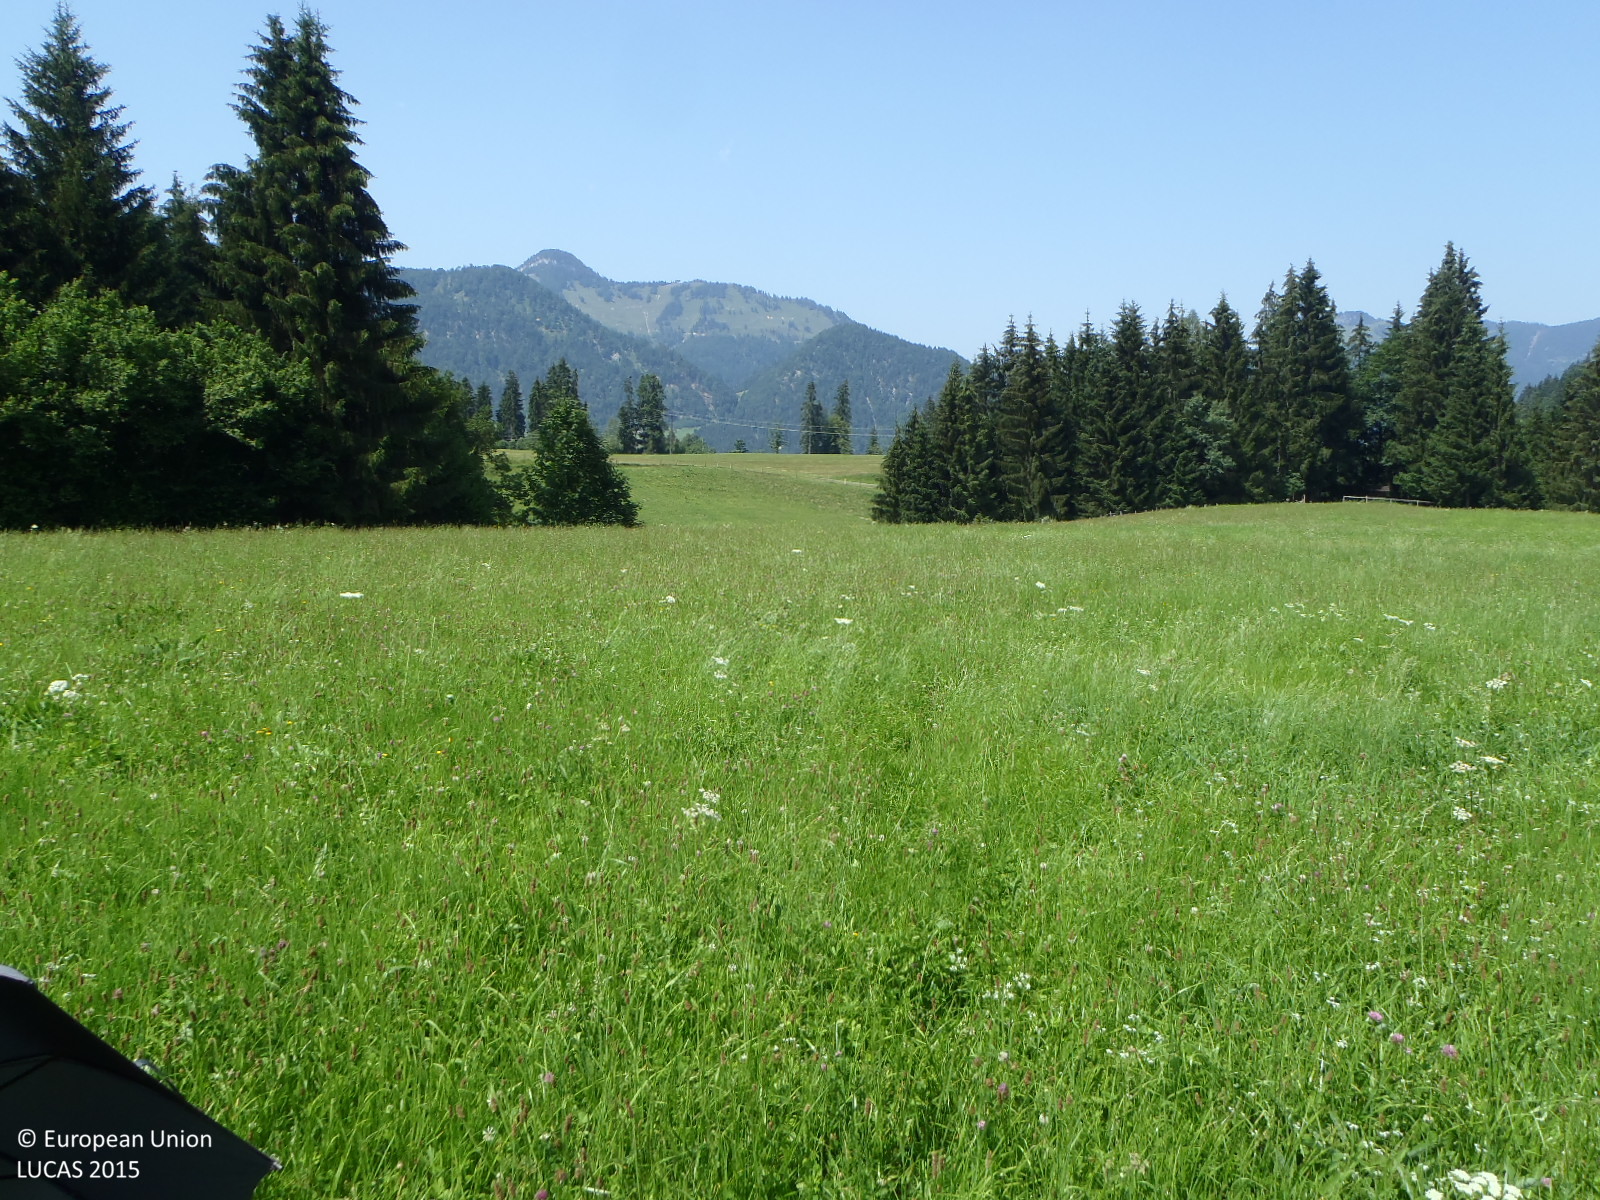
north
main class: Grassland
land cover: Grassland without tree/shrub cover
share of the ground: > 75 %
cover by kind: herbaceous plants 100 %
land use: Agriculture (excluding fallow land and kitchen gardens)
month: July
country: AT
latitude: 47.6397
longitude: 12.3811
